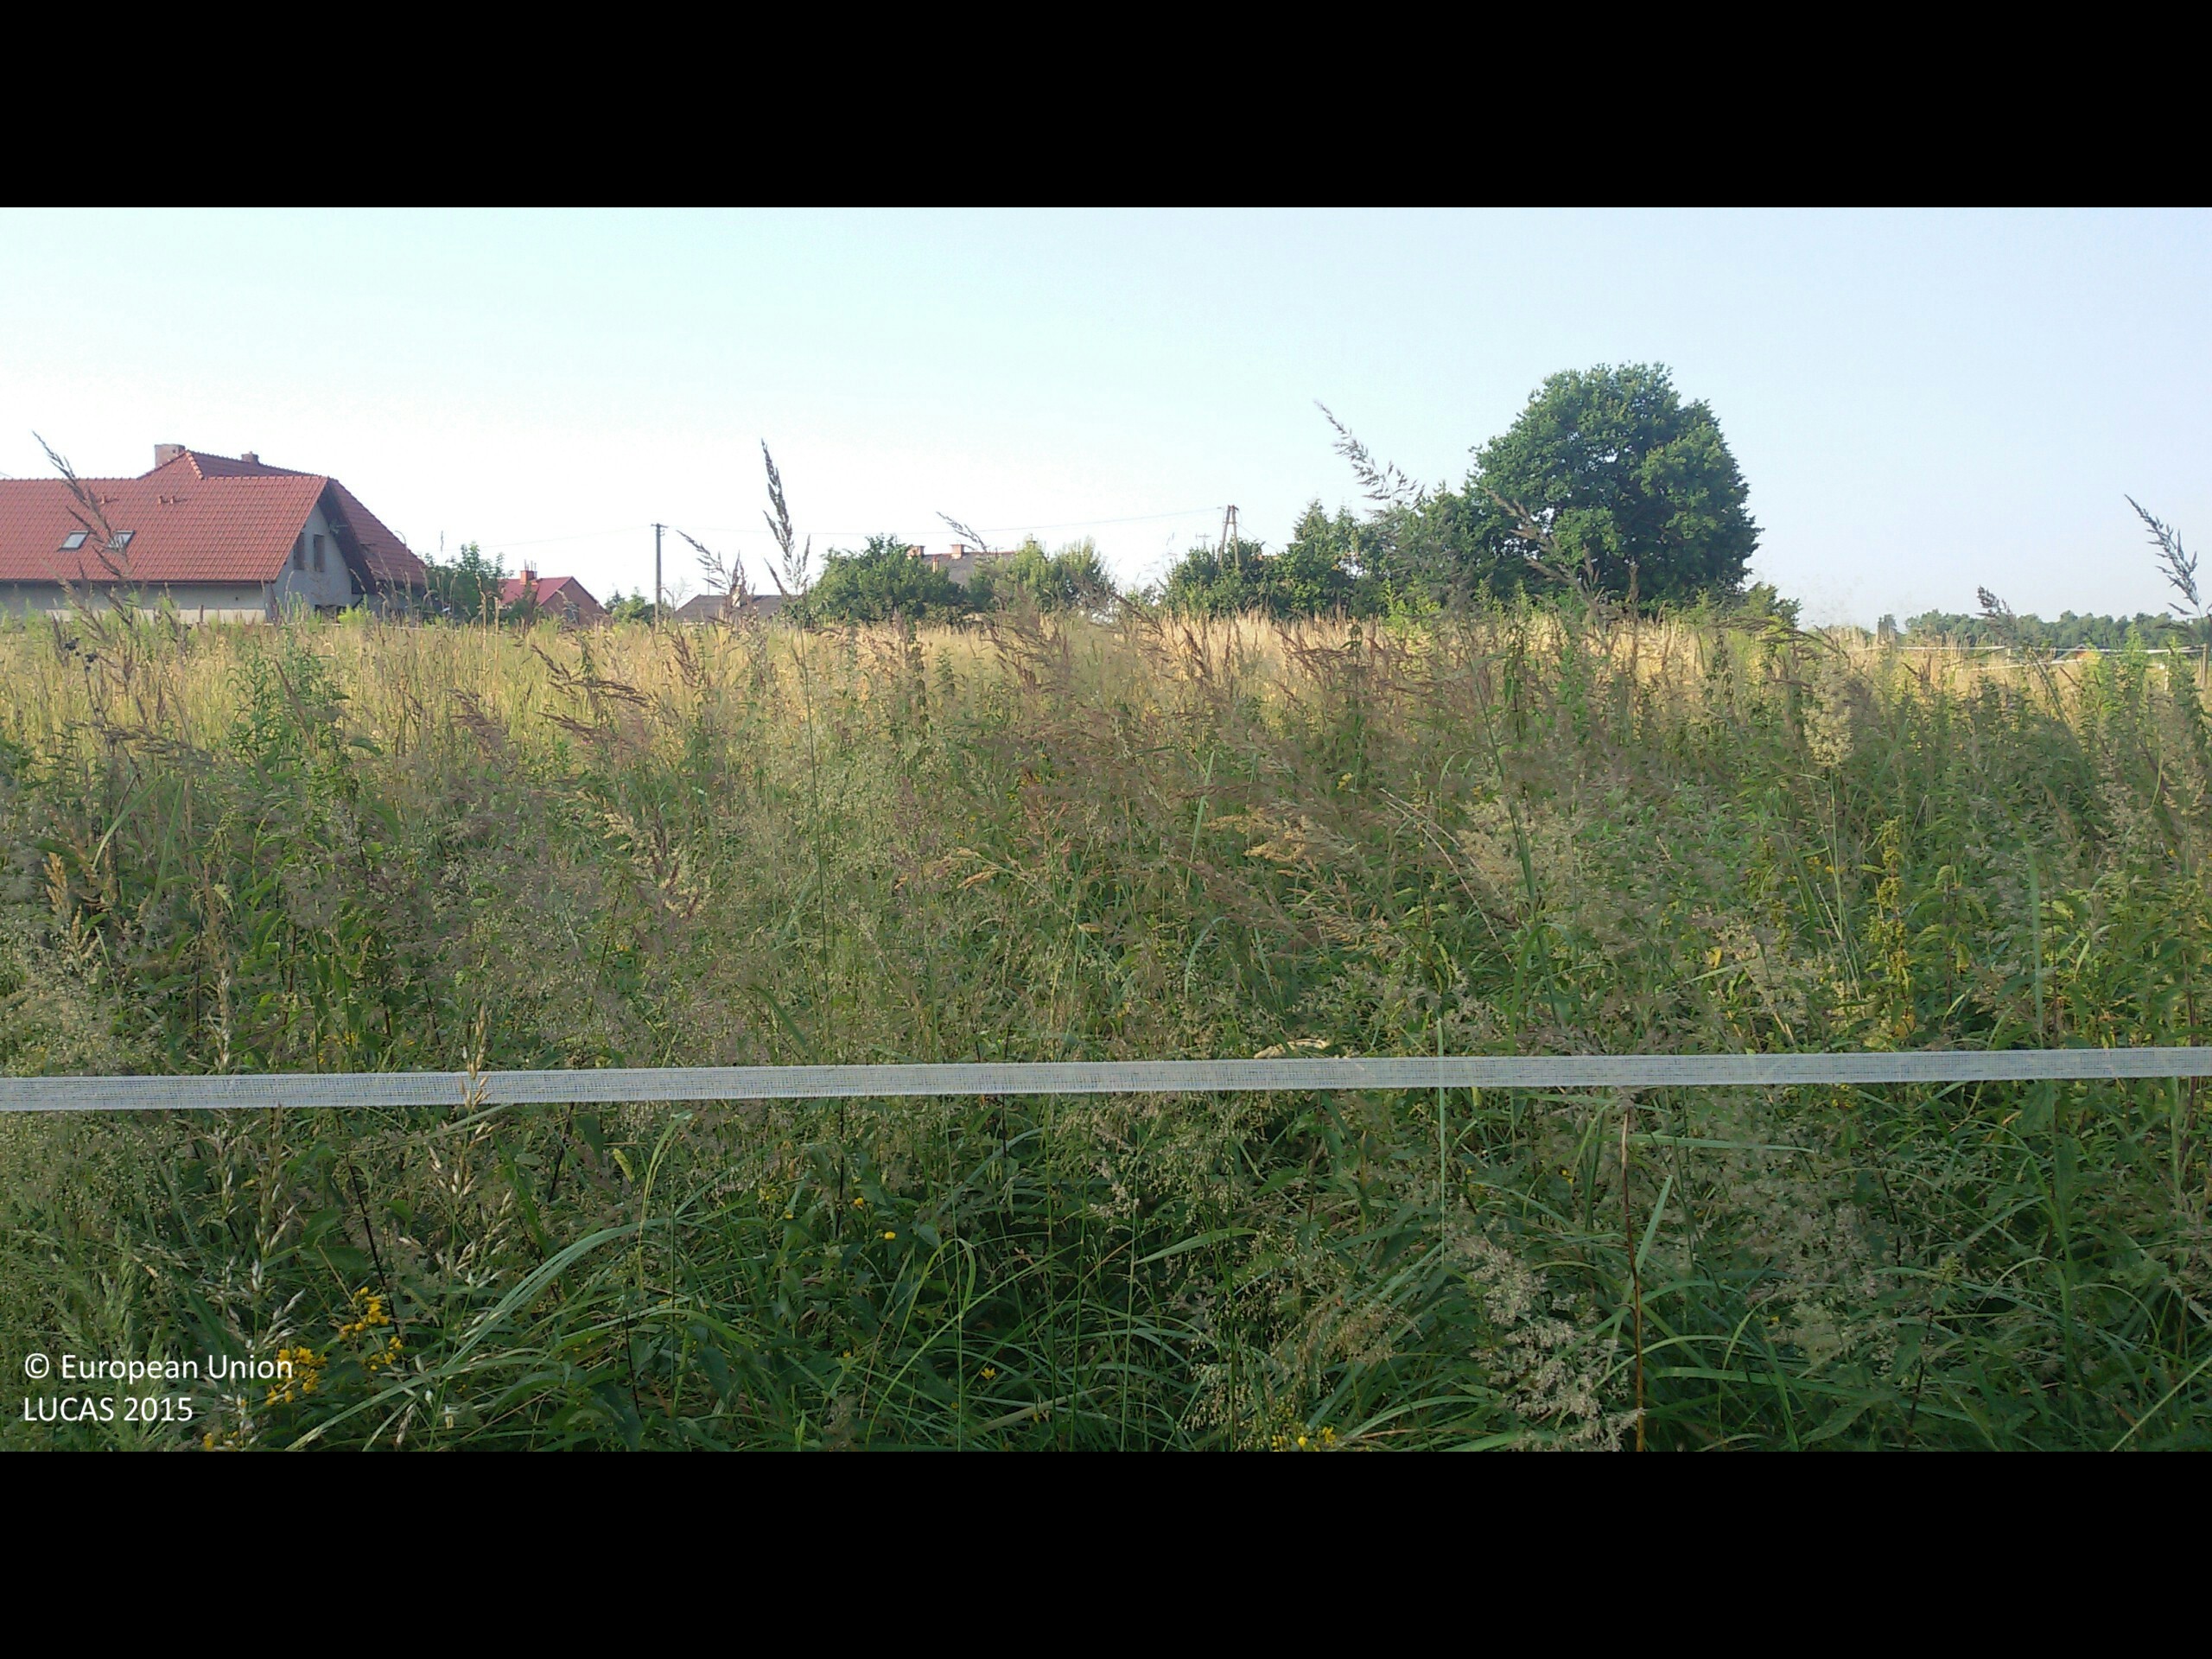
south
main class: Grassland
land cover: Grassland without tree/shrub cover
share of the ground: > 75 %
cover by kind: herbaceous plants 100 %
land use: Agriculture (excluding fallow land and kitchen gardens)
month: July
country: PL
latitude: 50.1402
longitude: 19.3869
